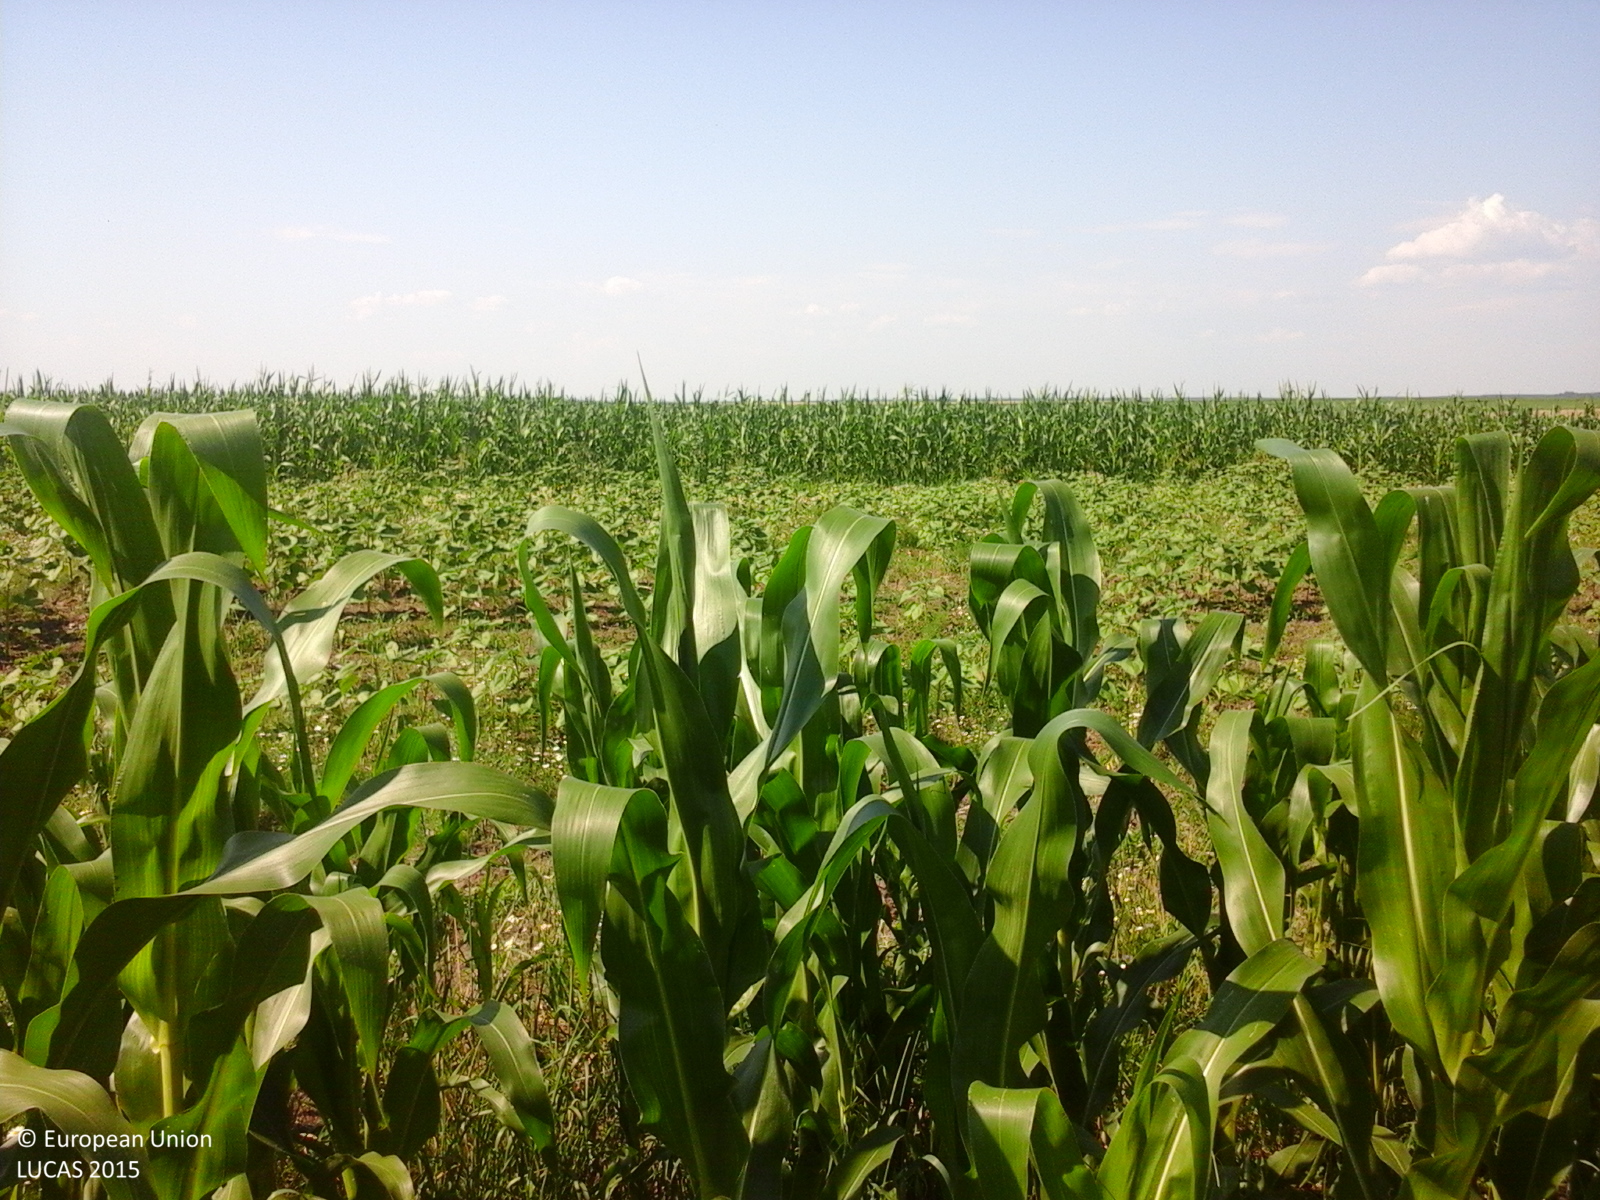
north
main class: Cropland
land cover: Maize
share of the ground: 50 - 75 %
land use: Agriculture (excluding fallow land and kitchen gardens)
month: July
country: RO
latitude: 44.5365
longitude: 24.6090
